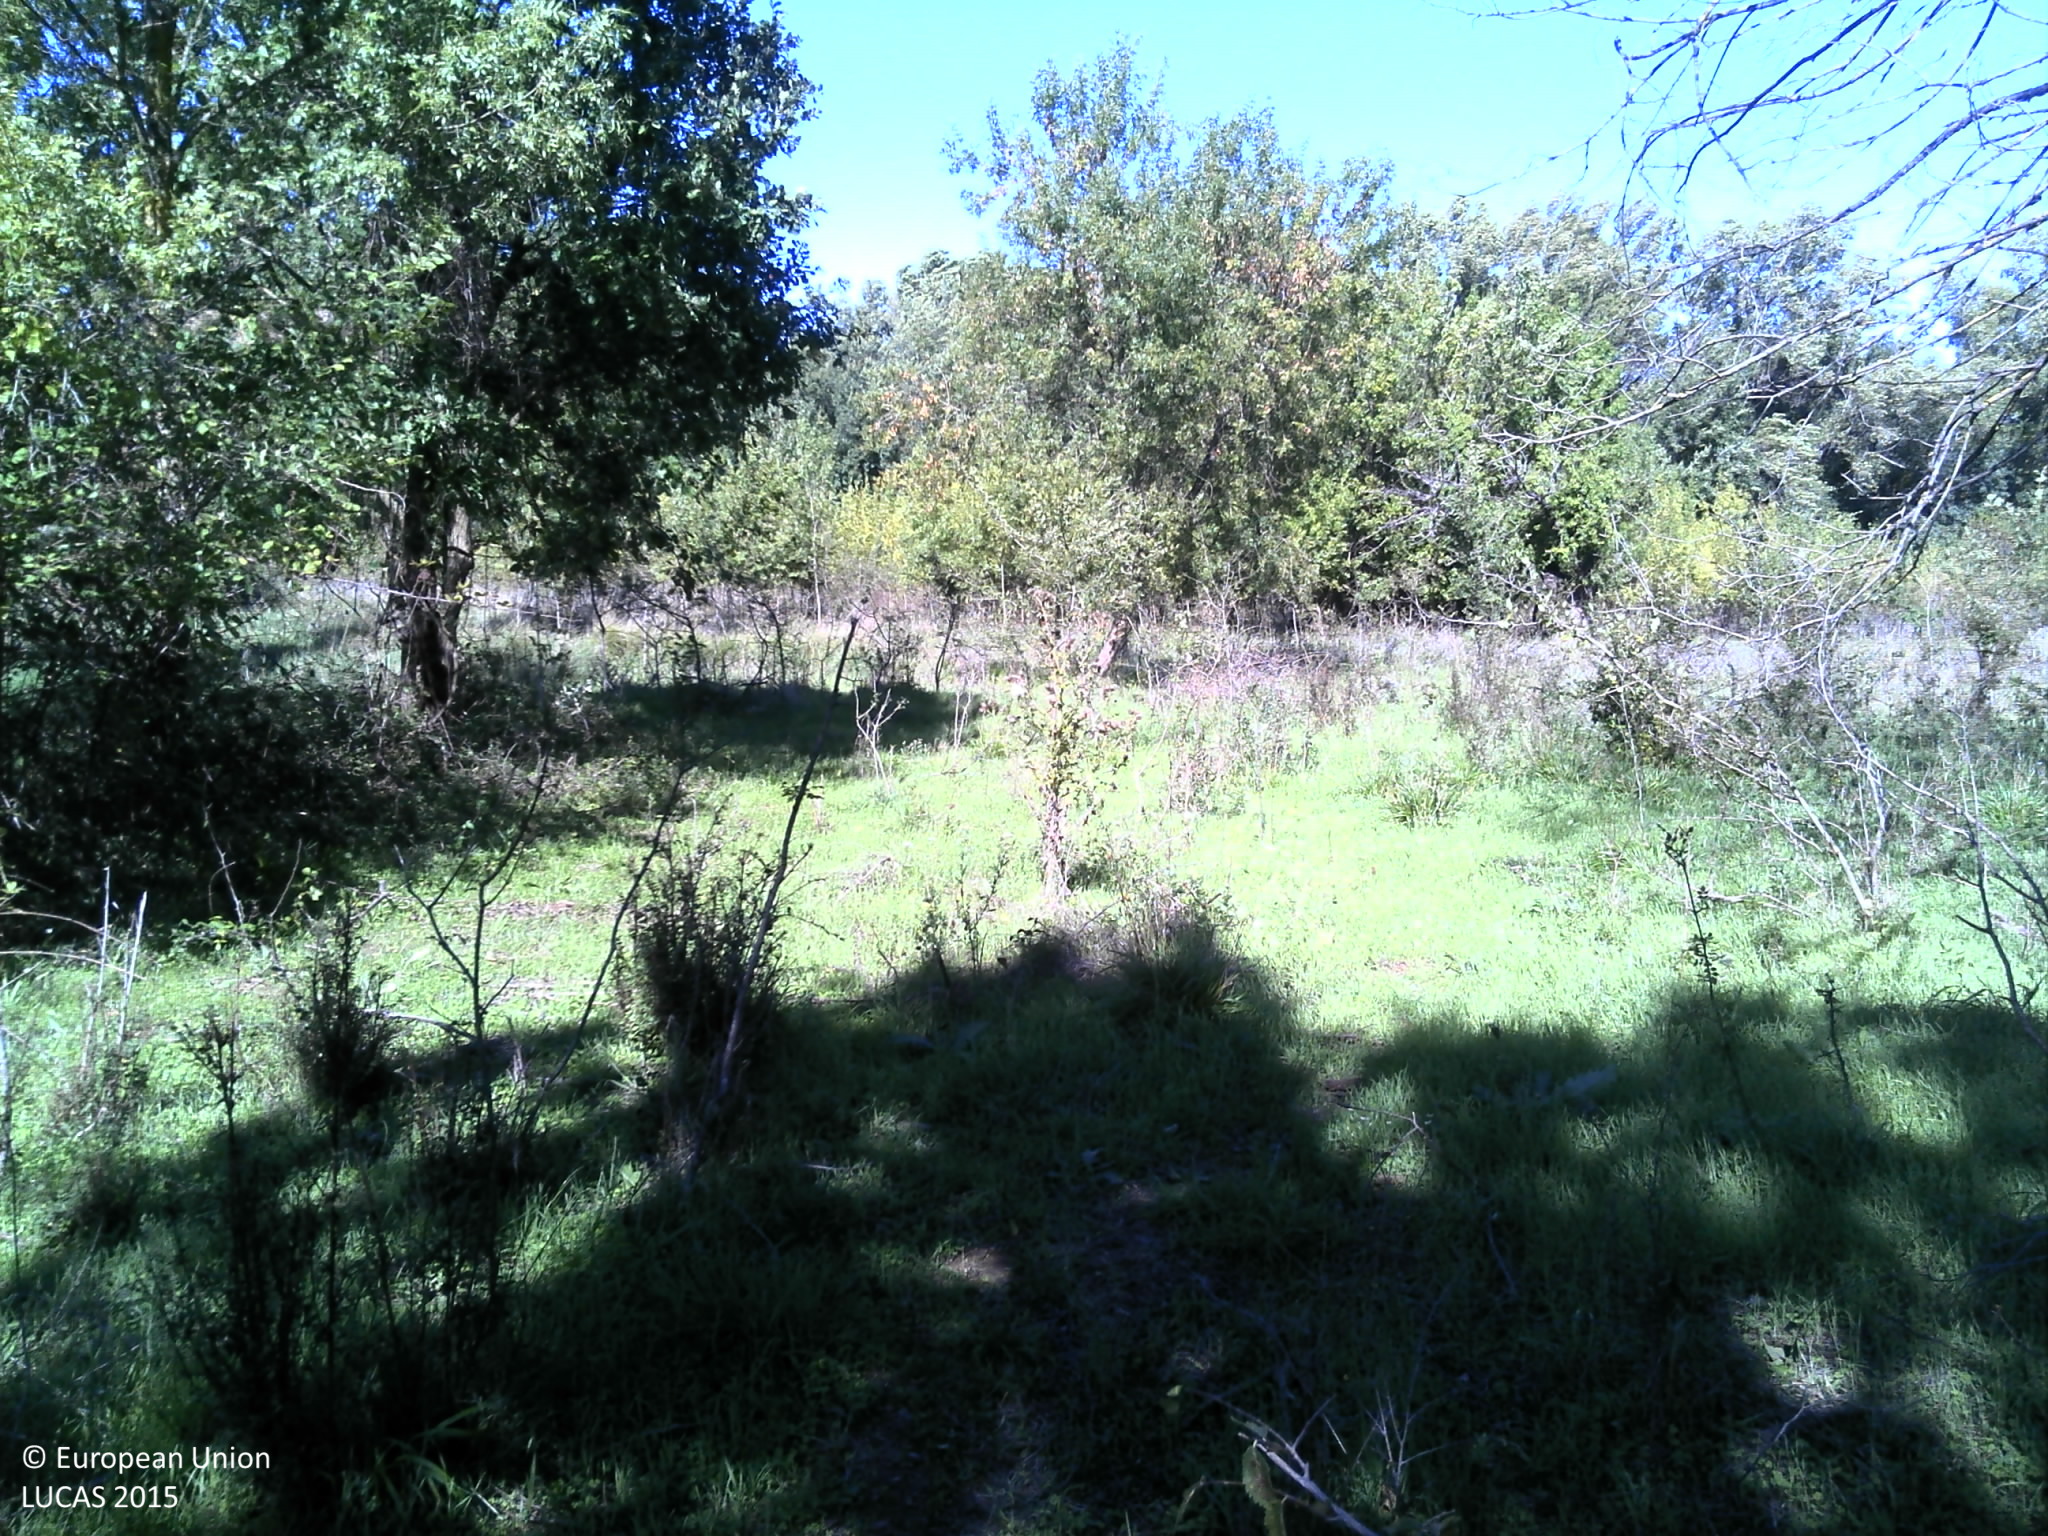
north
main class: Woodland
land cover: Broadleaved woodland
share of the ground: > 75 %
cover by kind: broadleaved forest trees 60 %, herbaceous plants 30 %, shrubs 10 %
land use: Forestry
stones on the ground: < 10 %
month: October
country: FR
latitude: 43.4638
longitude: 6.5847
